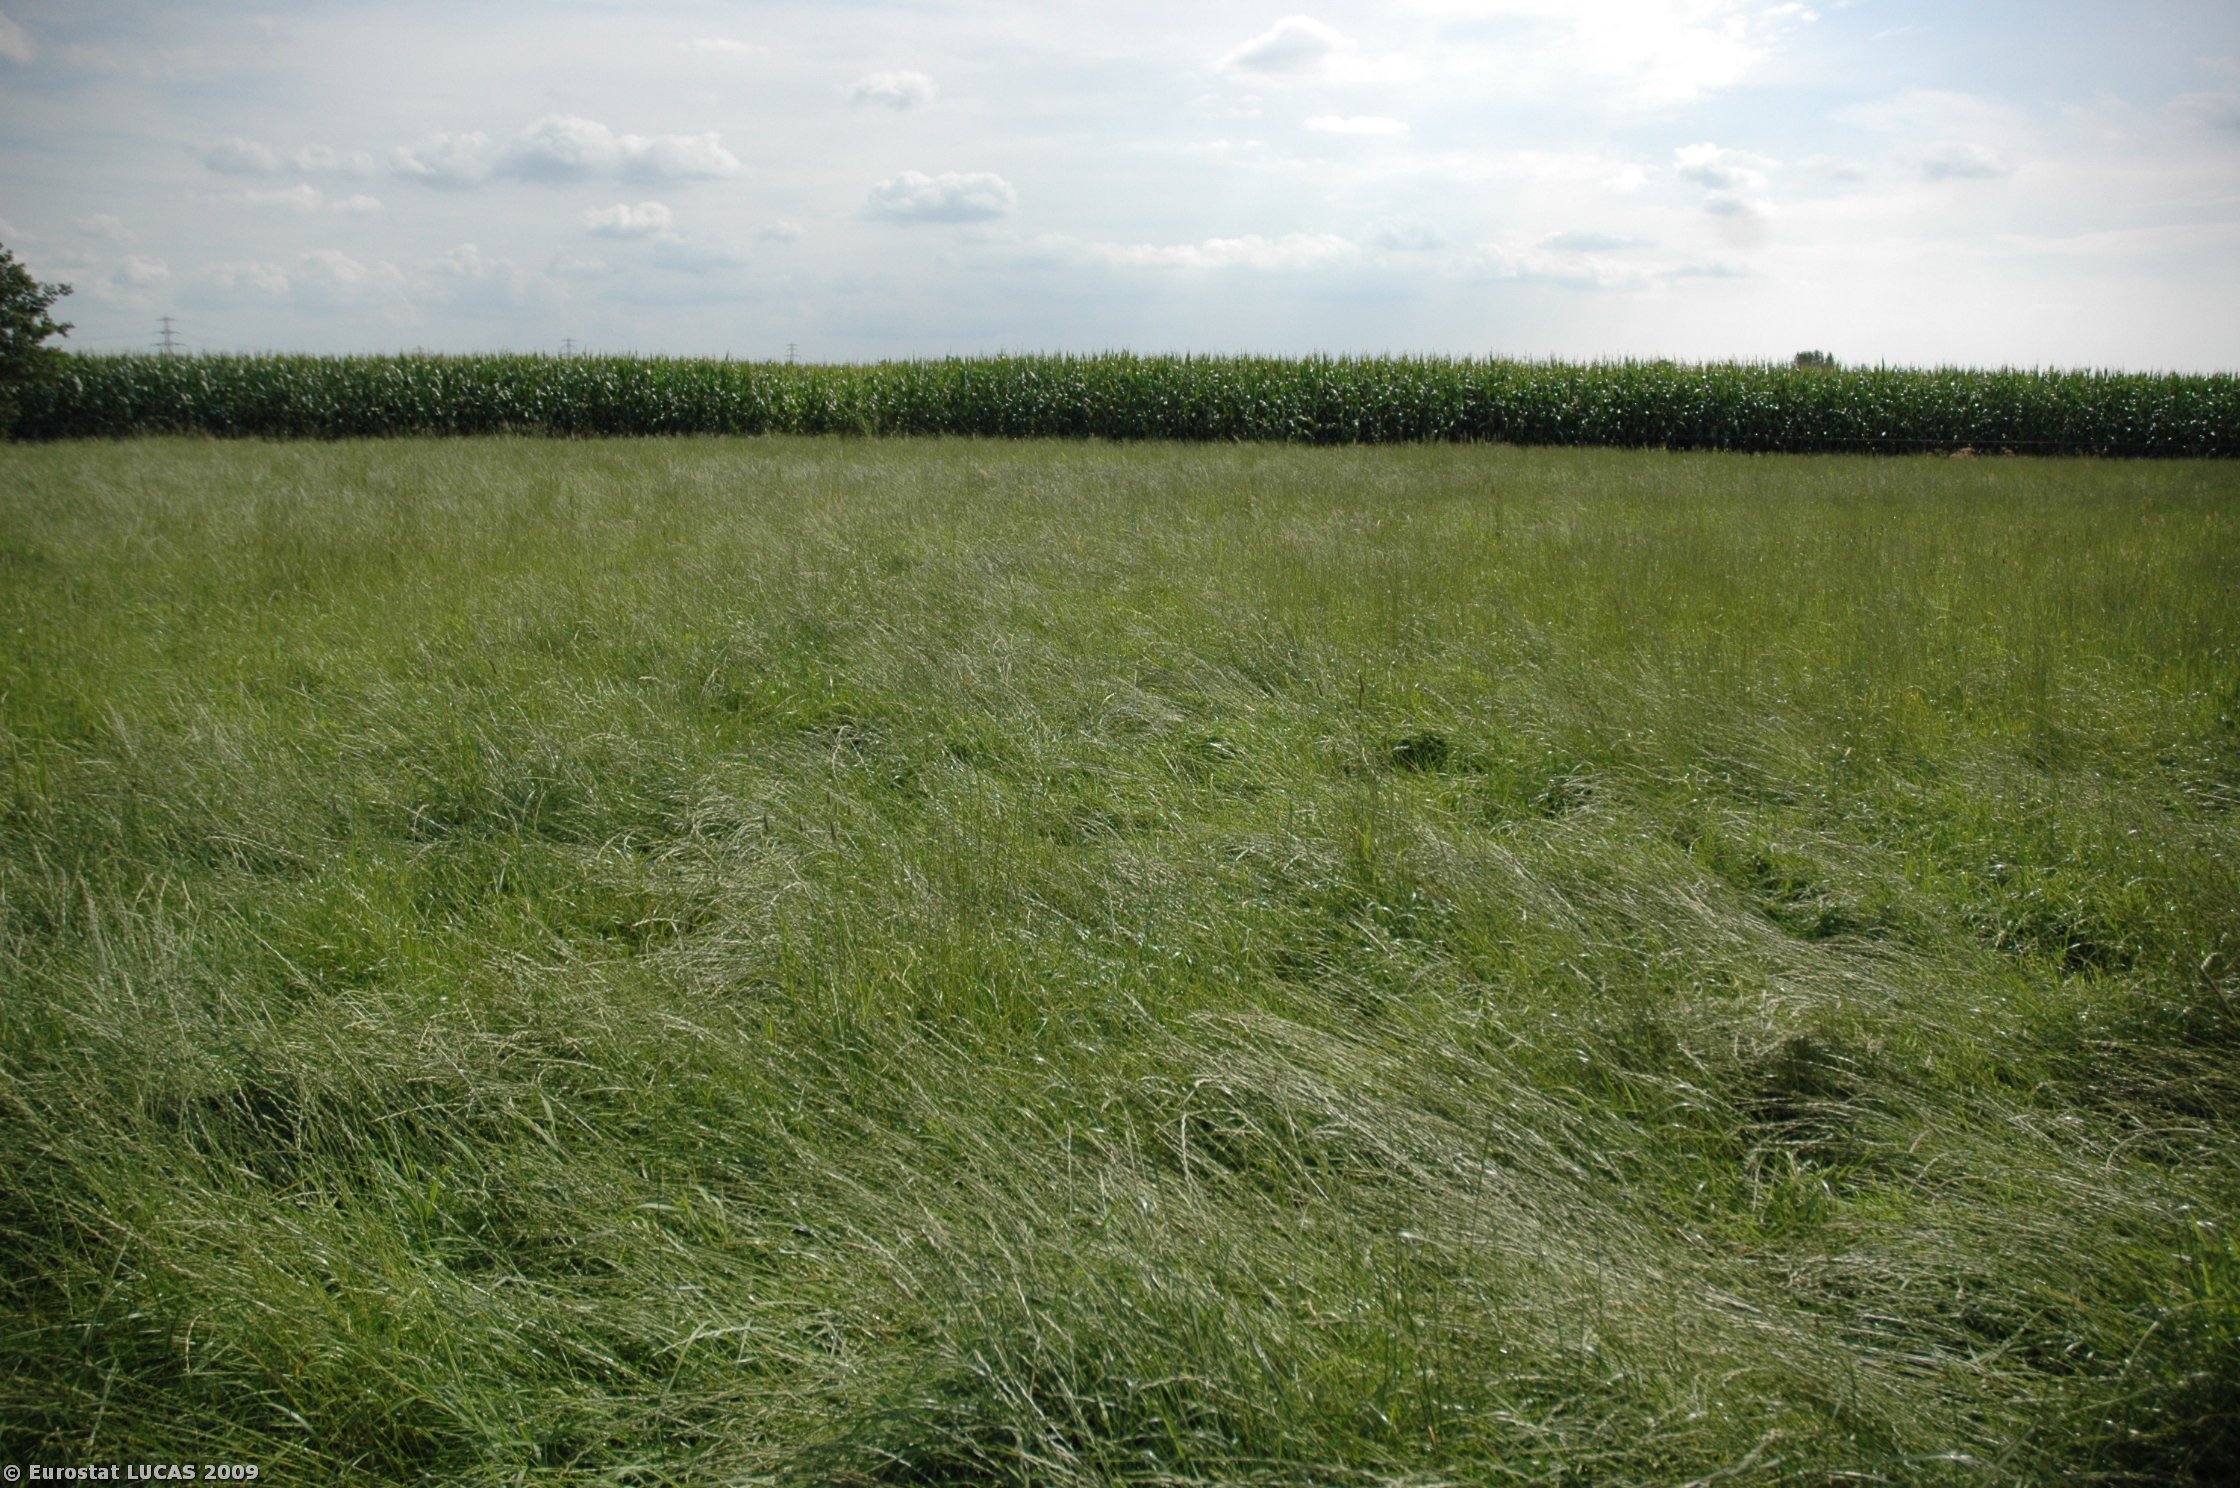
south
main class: Grassland
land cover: Grassland without tree/shrub cover
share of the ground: > 75 %
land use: Agriculture (excluding fallow land and kitchen gardens)
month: August
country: NL
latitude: 52.4026
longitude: 6.0749
